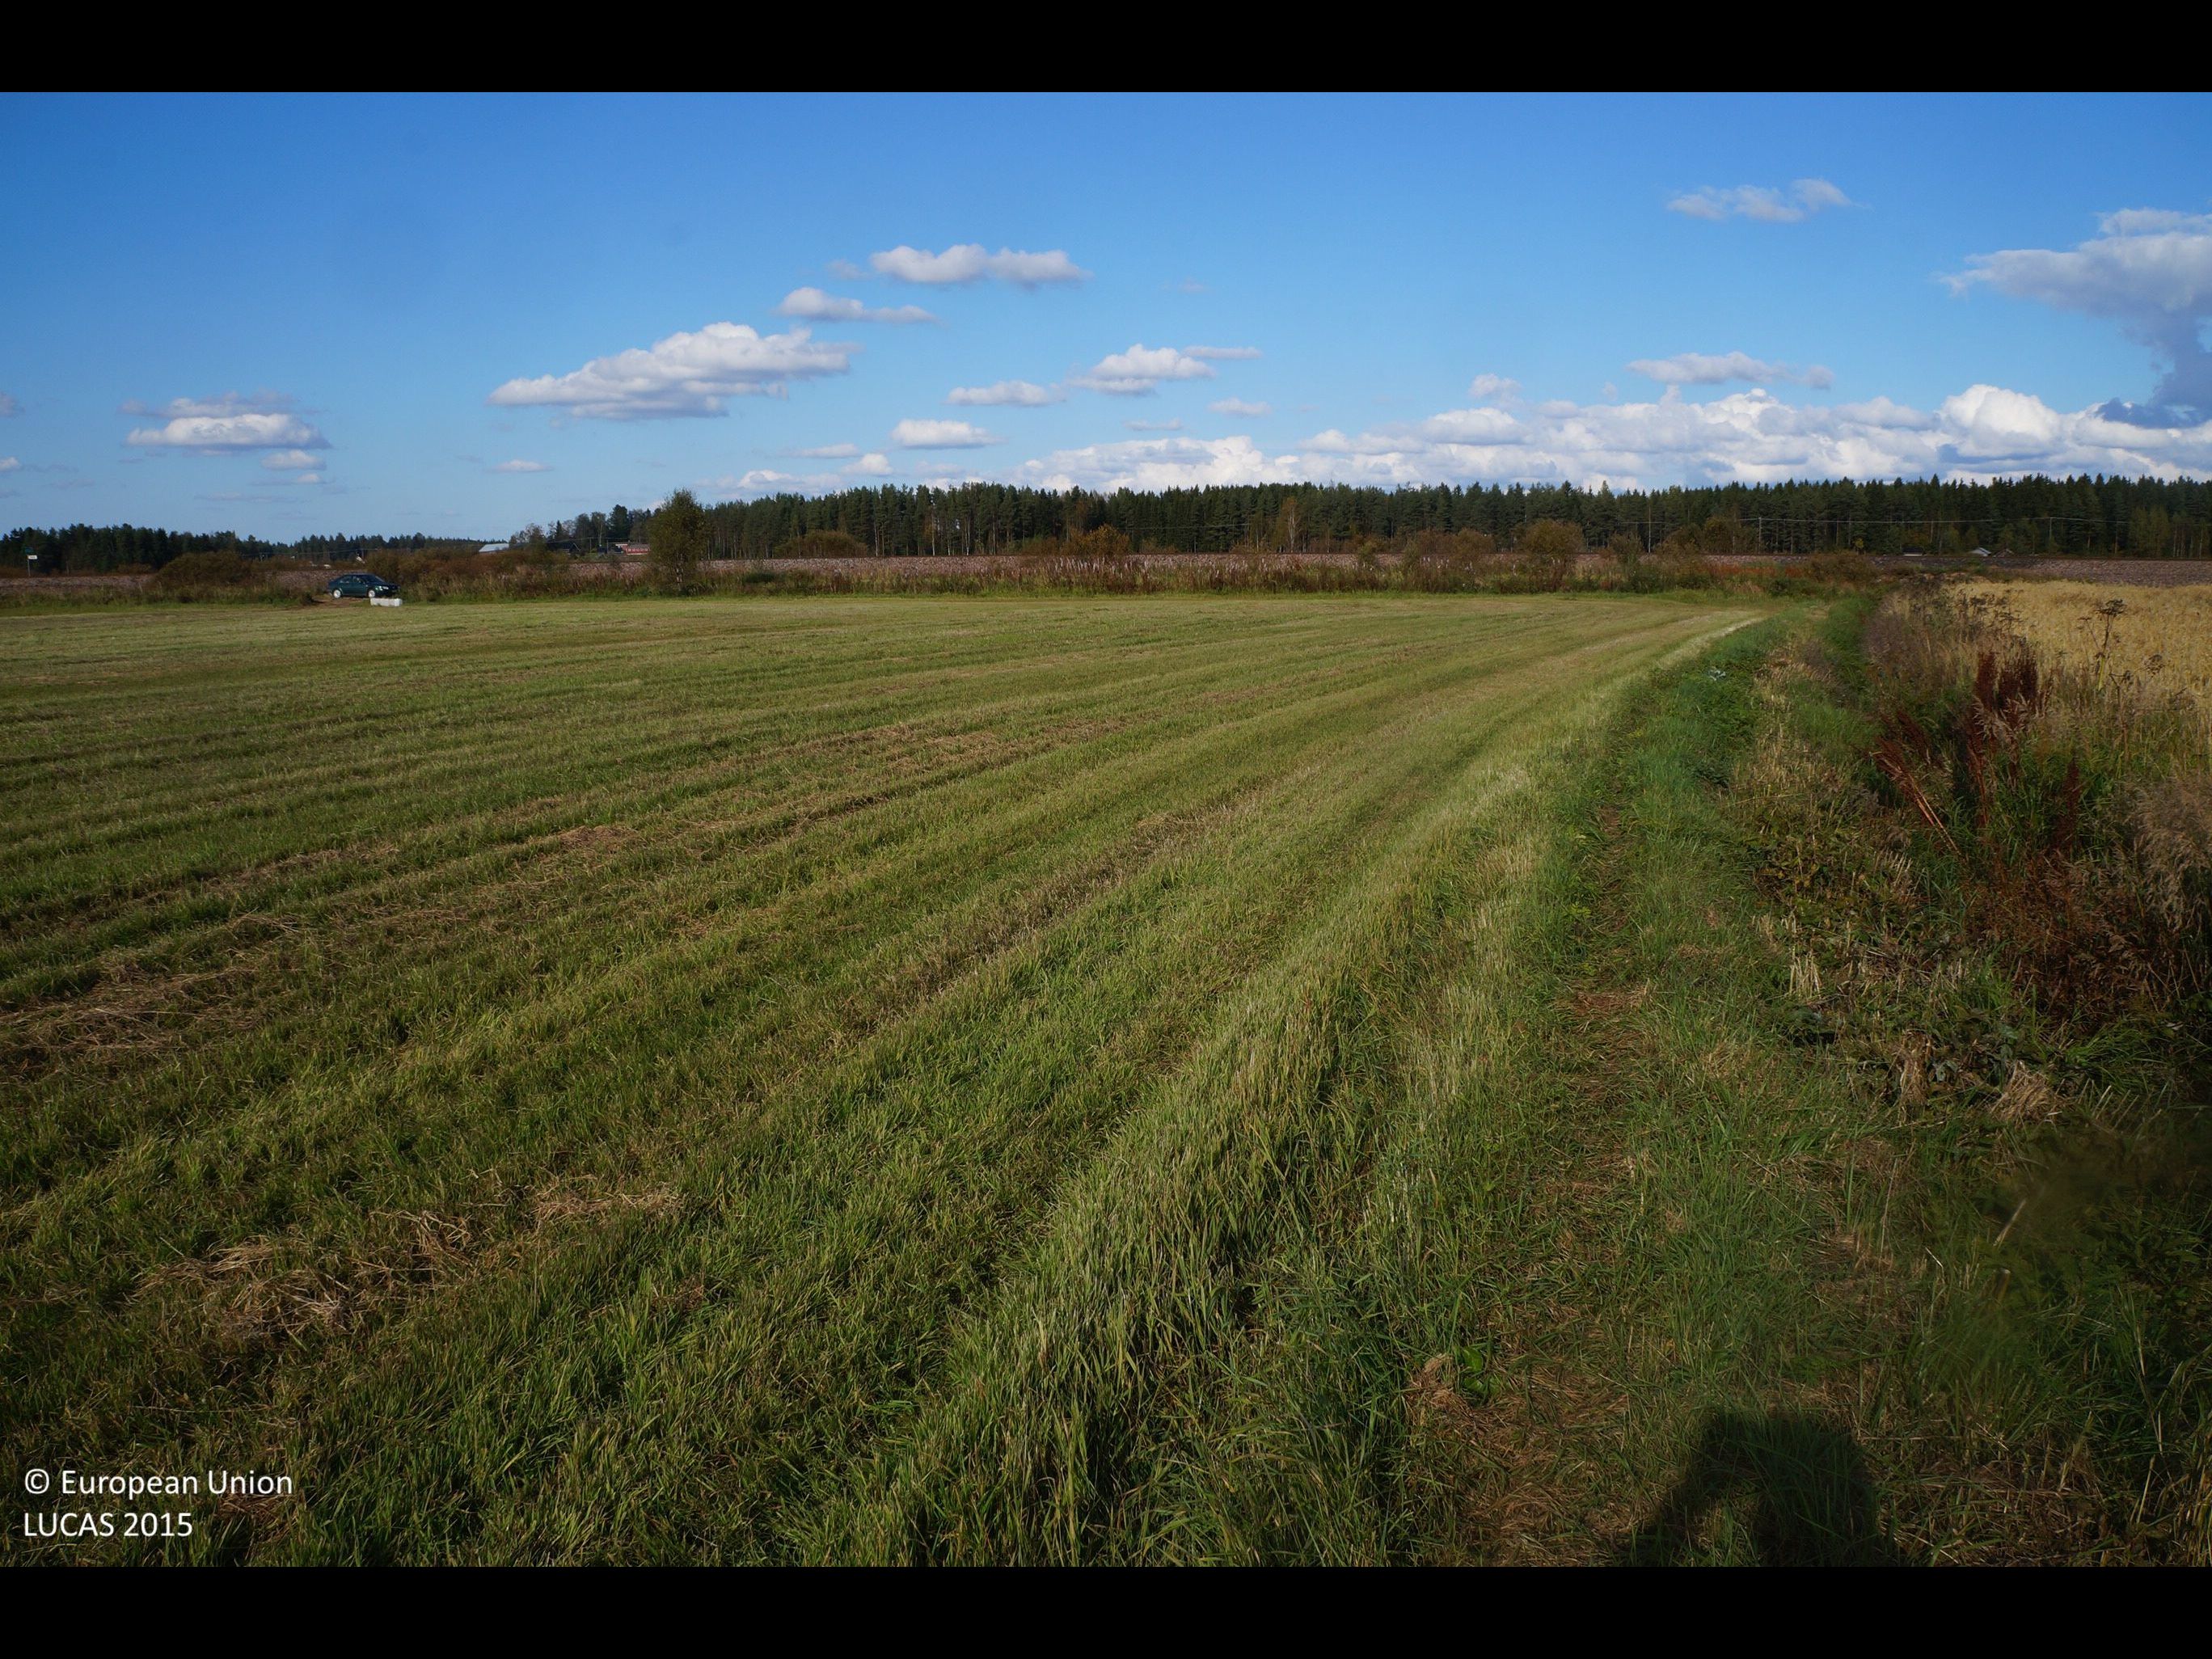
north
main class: Cropland
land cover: Barley
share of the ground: > 75 %
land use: Agriculture (excluding fallow land and kitchen gardens)
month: September
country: FI
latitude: 64.0637
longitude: 24.6470
